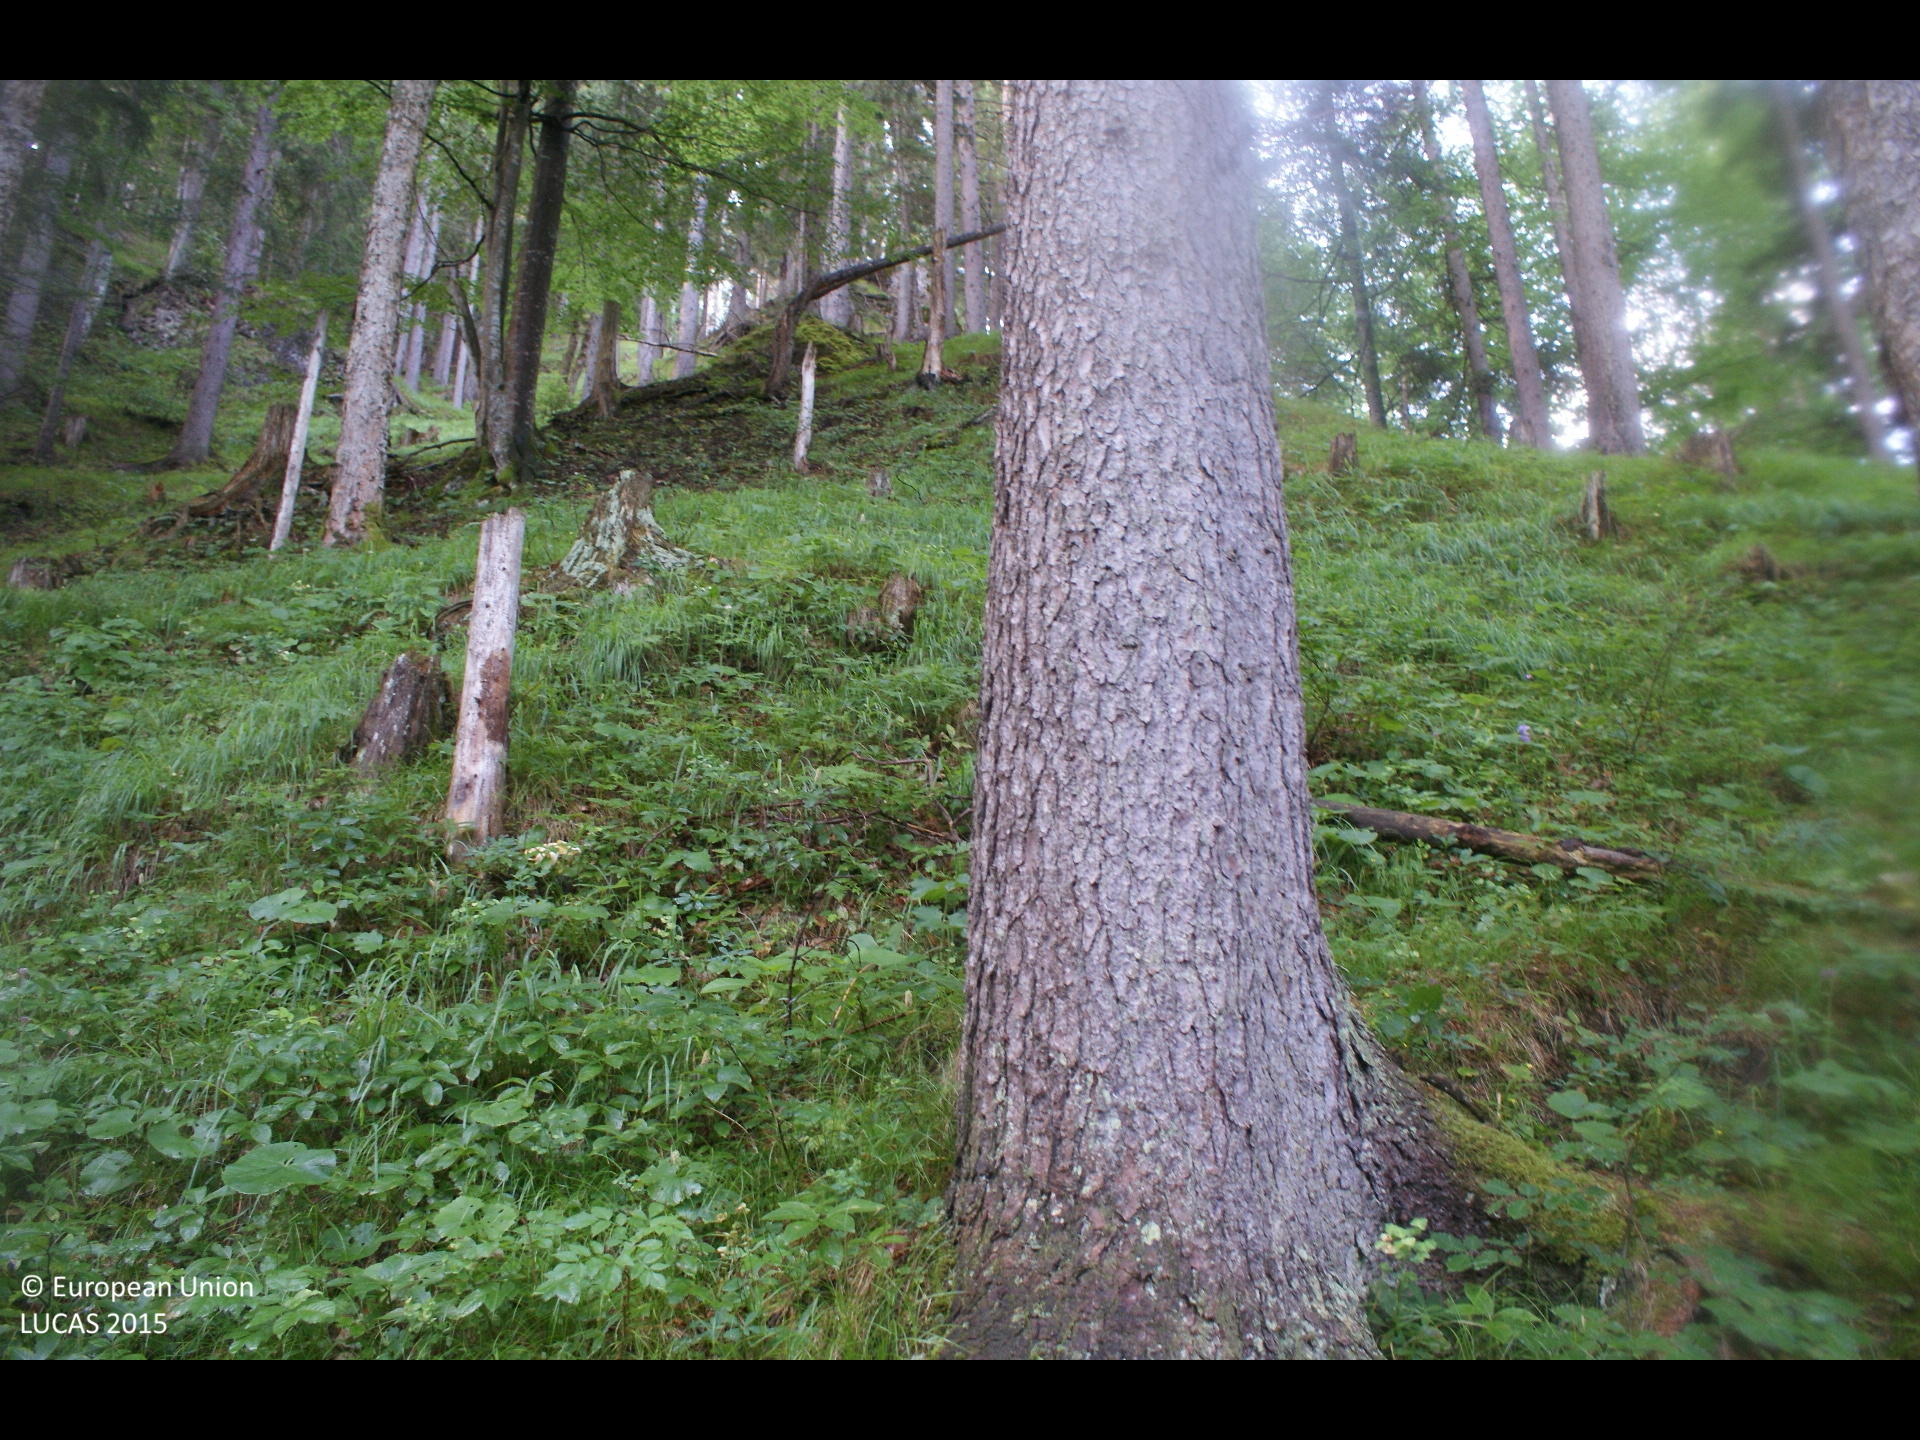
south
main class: Woodland
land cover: Spruce dominated mixed woodland
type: mountainous beech forest
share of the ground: > 75 %
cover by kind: coniferous forest trees 65 %, broadleaved forest trees 25 %, herbaceous plants 10 %
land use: Forestry
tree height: > 5 m
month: July
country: AT
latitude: 47.7869
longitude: 15.3537
